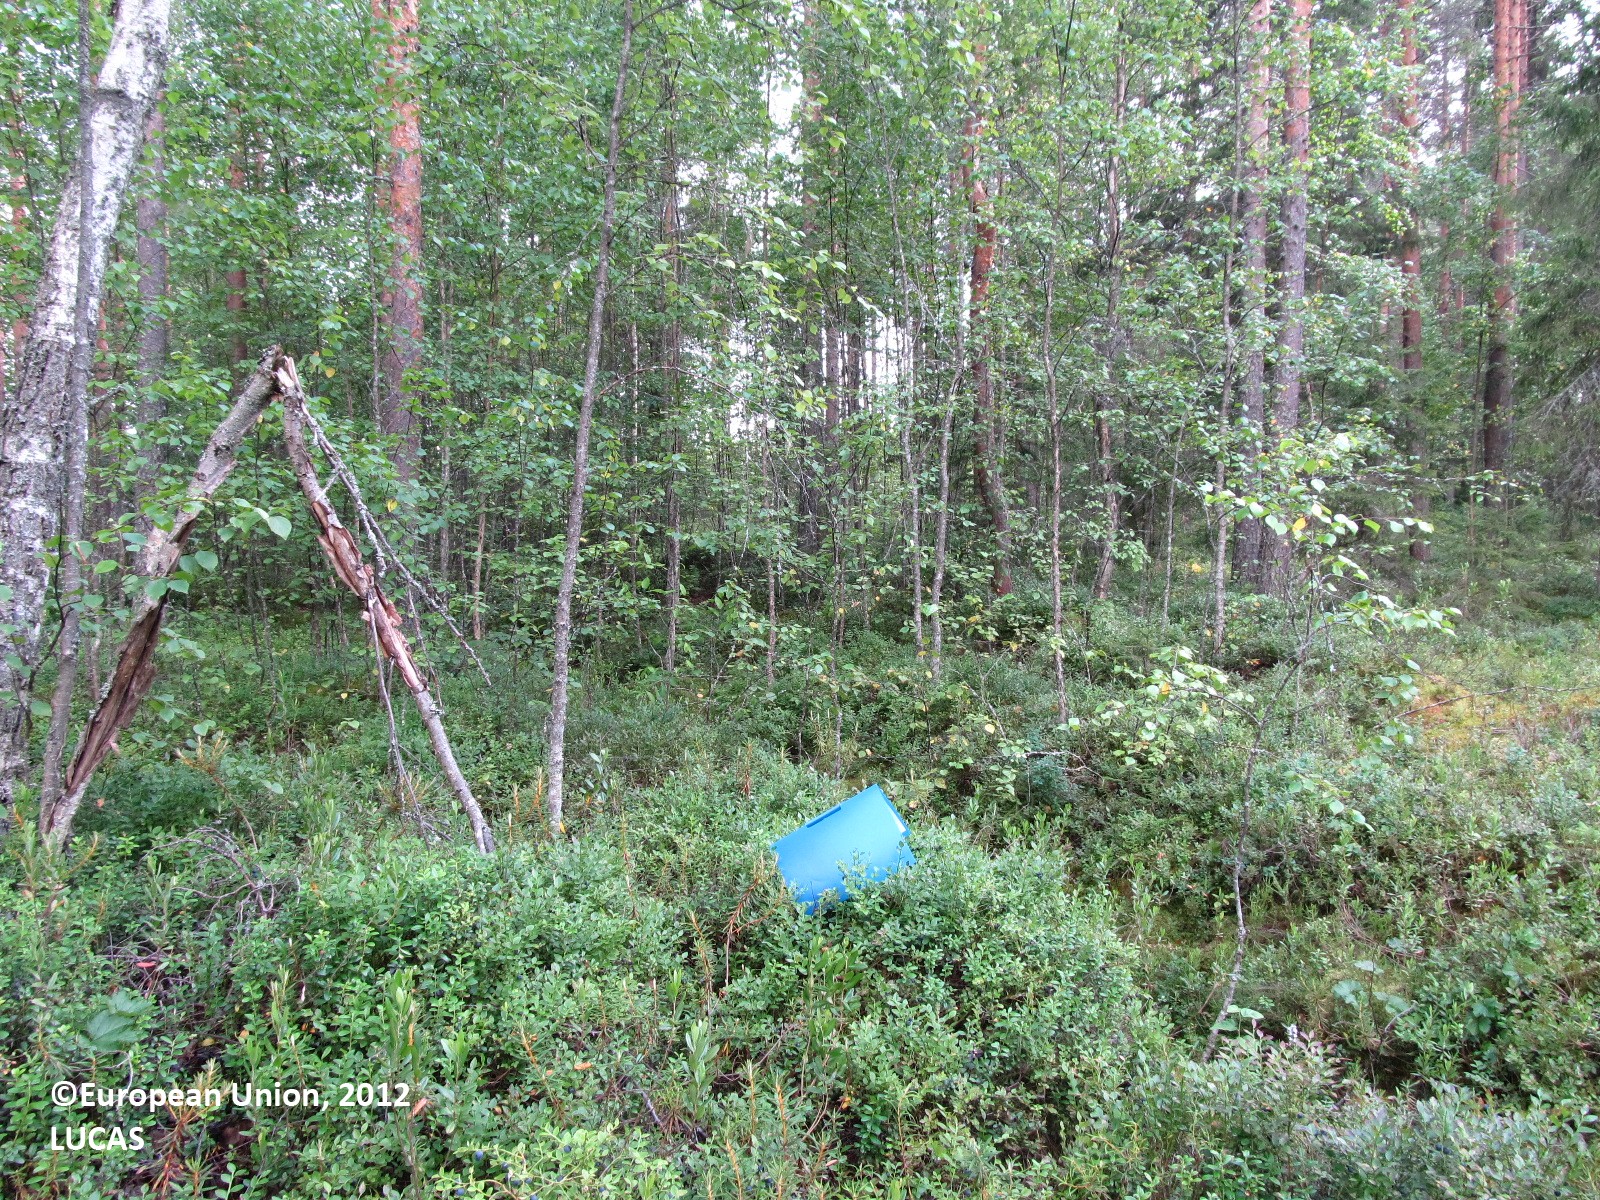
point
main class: Woodland
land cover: Pine dominated mixed woodland
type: boreal forest
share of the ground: 25 - 50 %
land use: Forestry
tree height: > 5 m
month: July
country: FI
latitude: 61.8178
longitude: 27.9357
